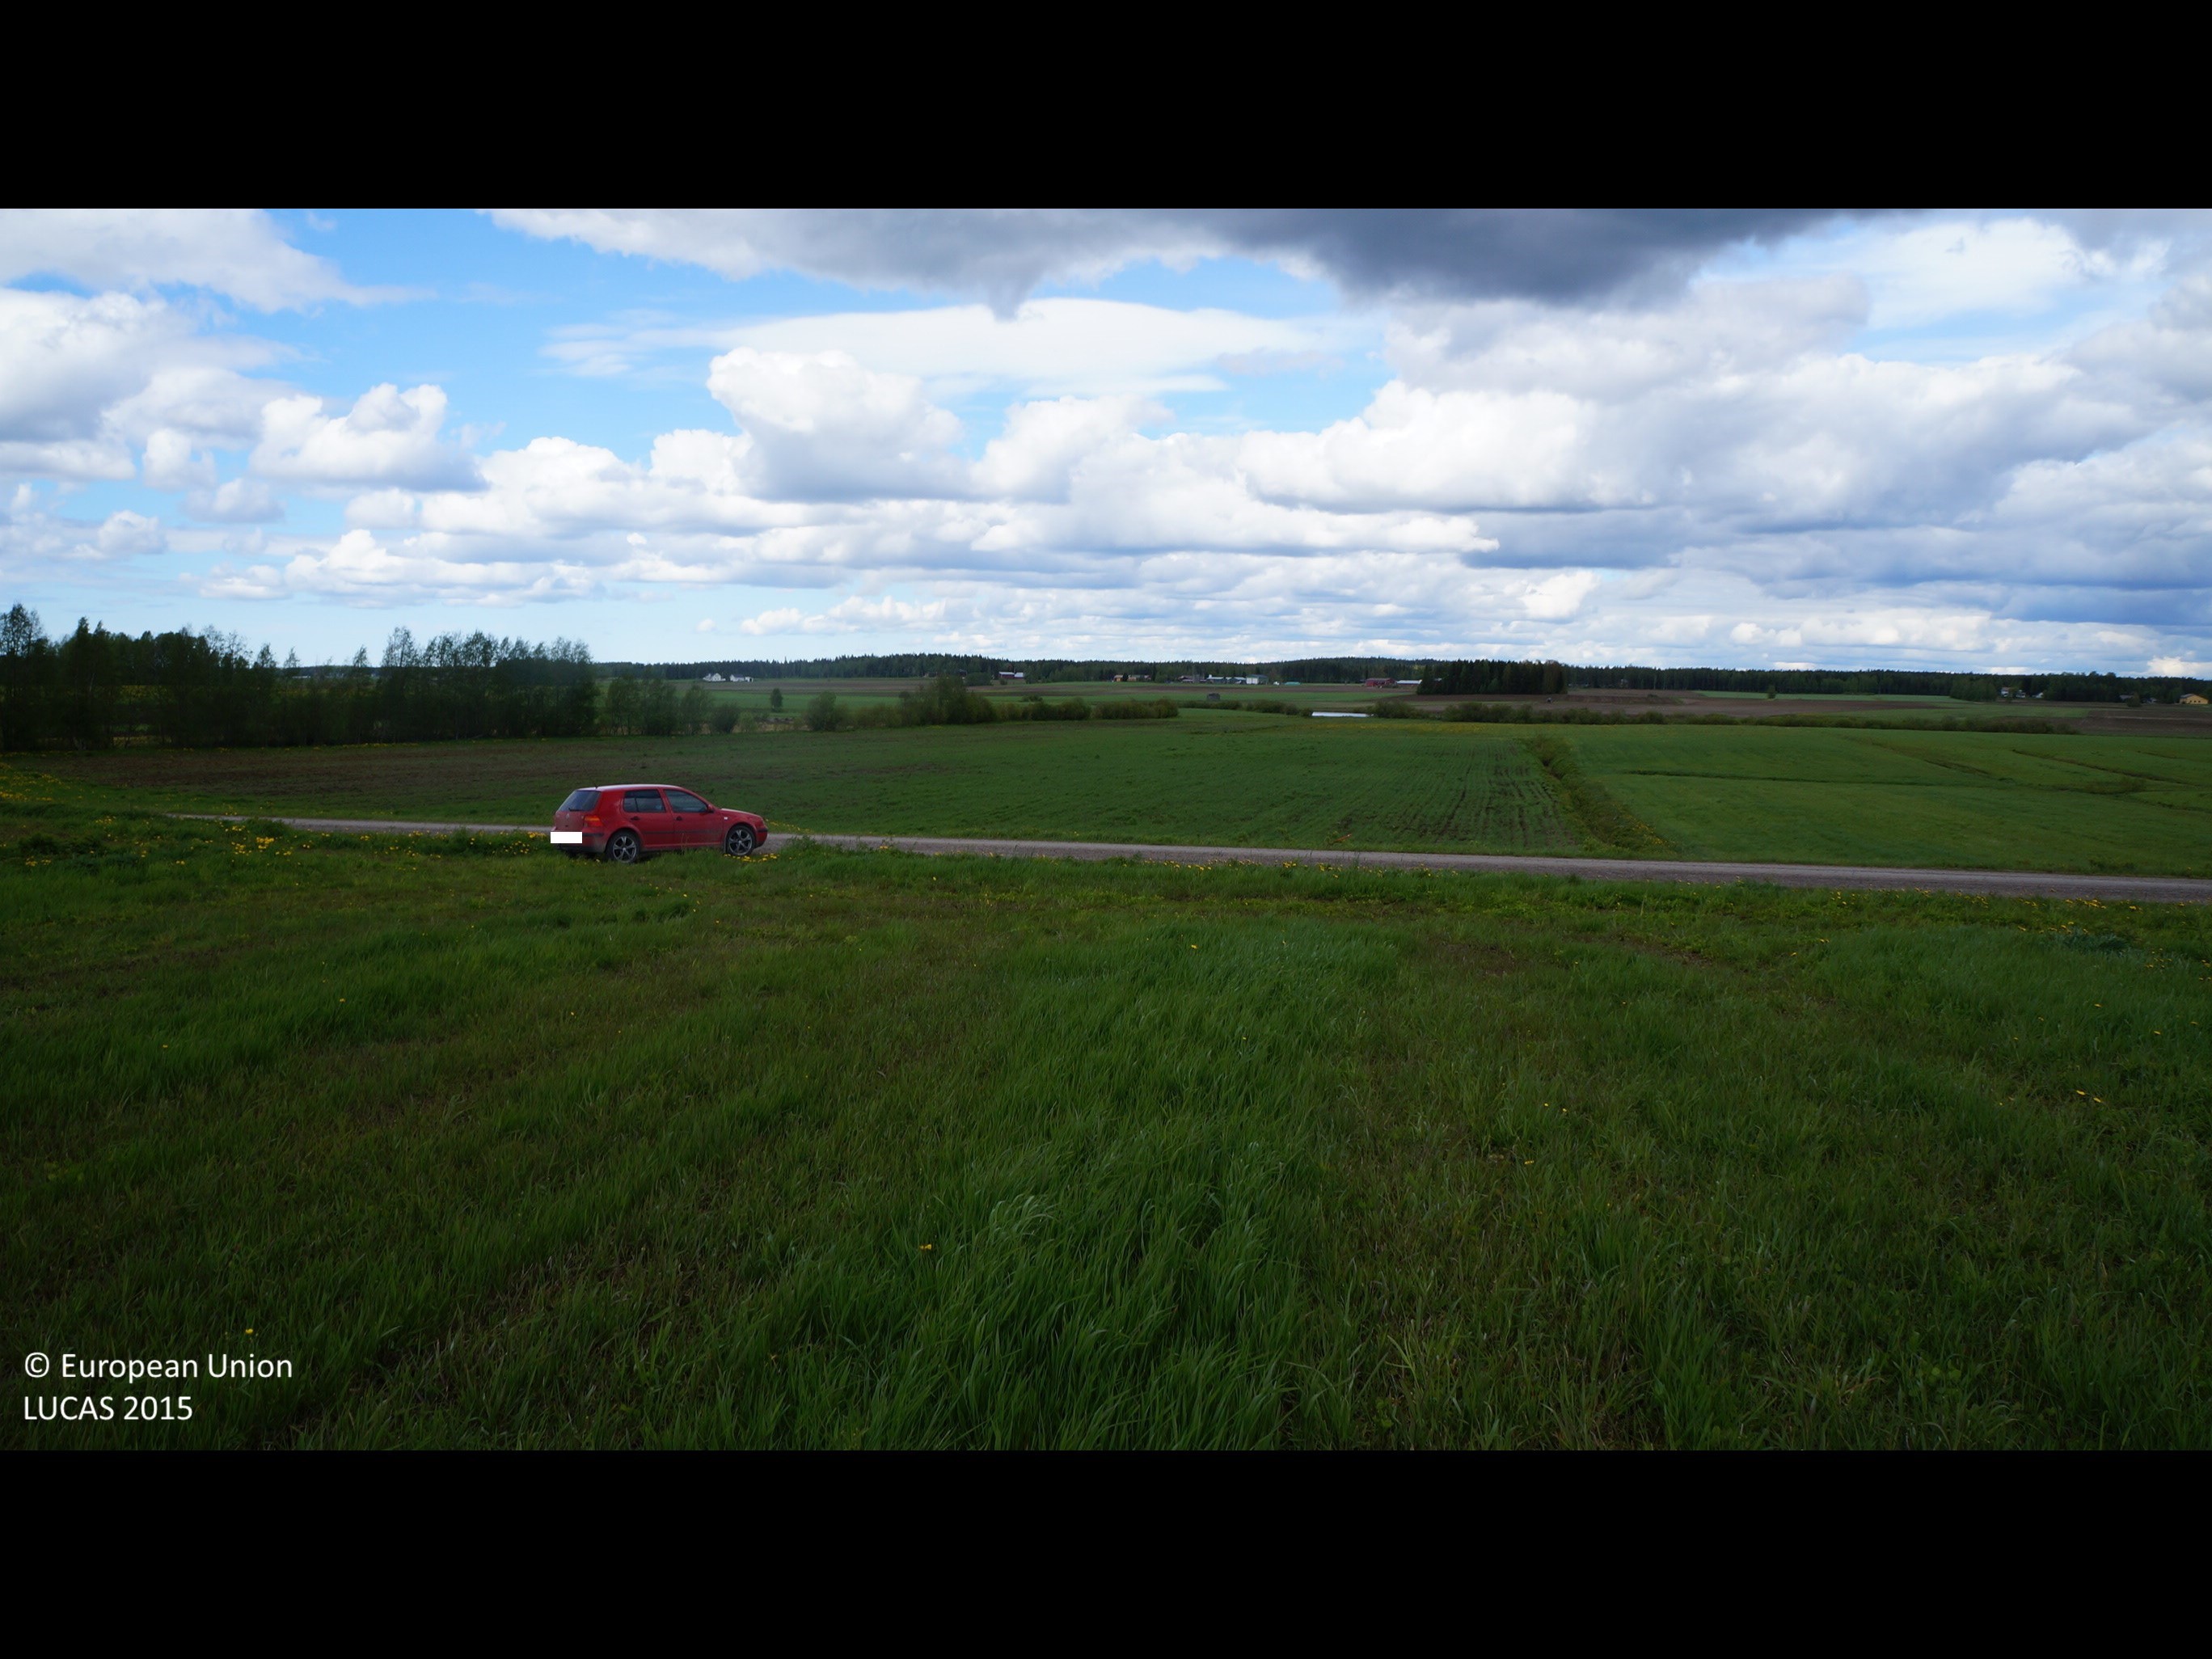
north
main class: Cropland
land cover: Temporary grasslands
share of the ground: > 75 %
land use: Agriculture (excluding fallow land and kitchen gardens)
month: June
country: FI
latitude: 63.7942
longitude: 24.1770
